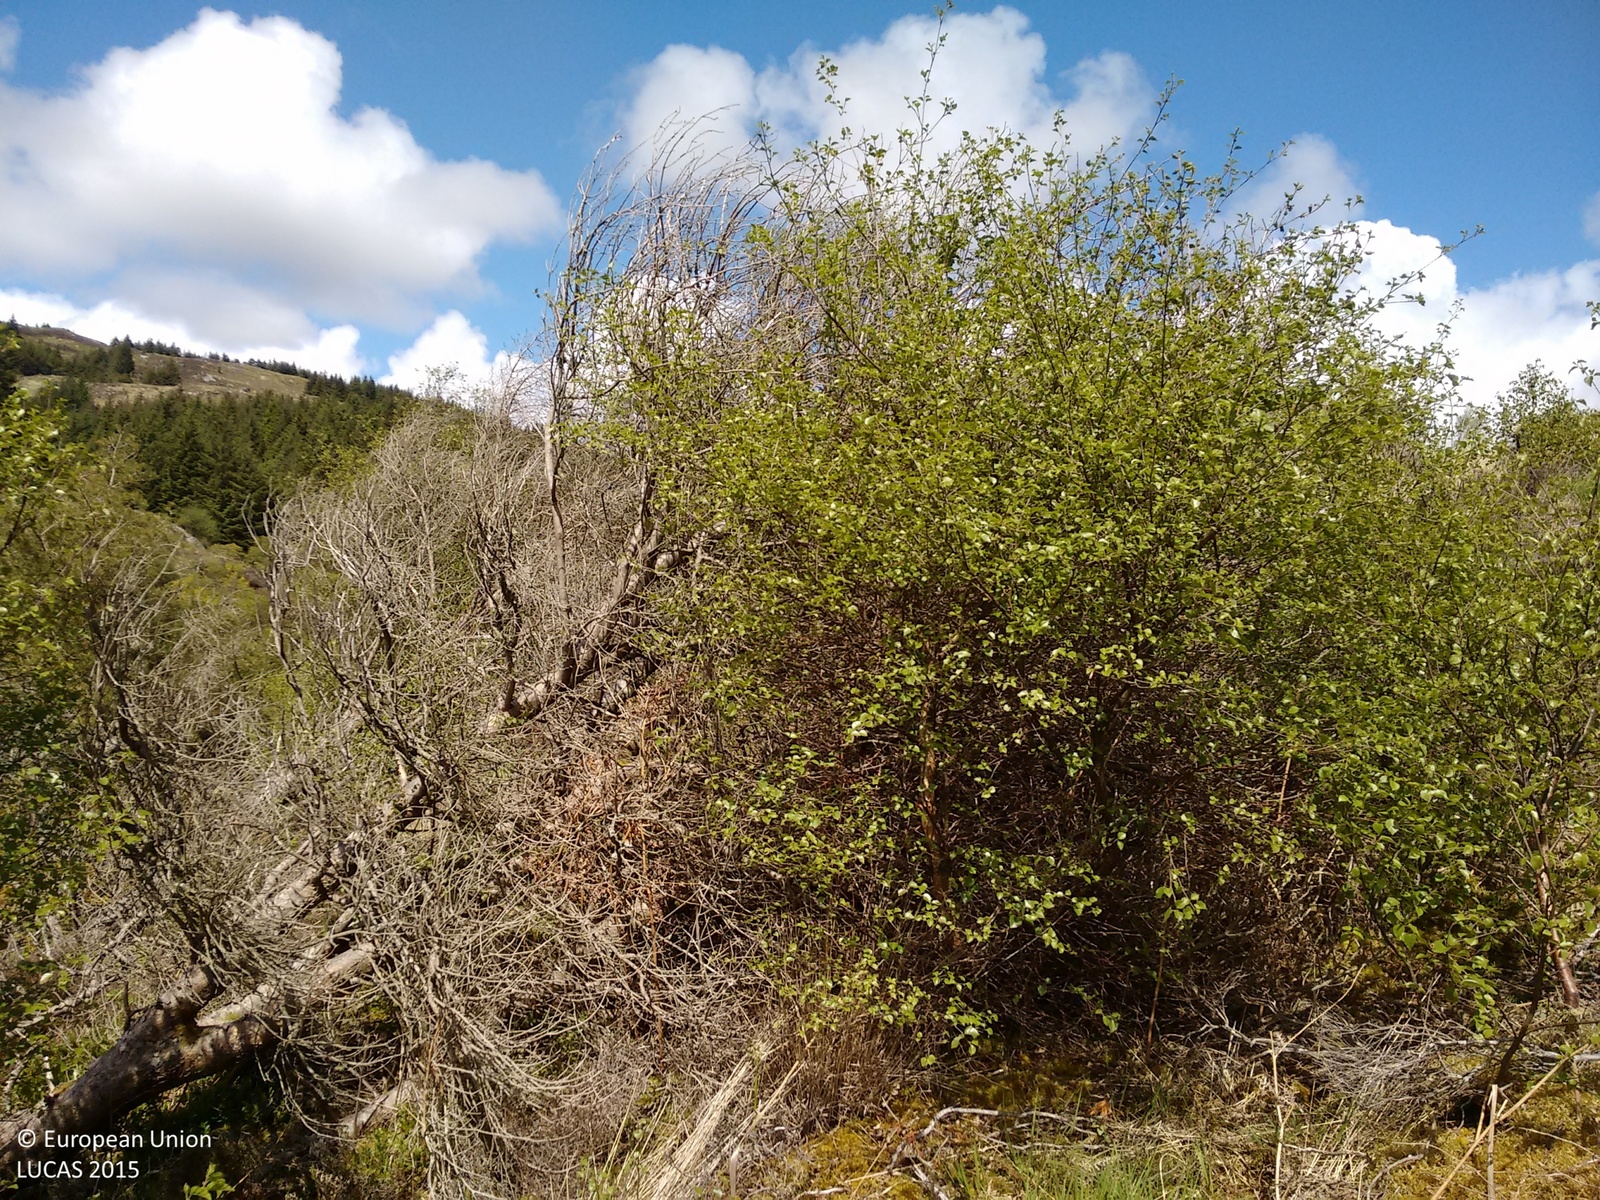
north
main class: Woodland
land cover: Broadleaved woodland
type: acidophilous oak and oak-birch forest
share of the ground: > 75 %
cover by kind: broadleaved forest trees 95 %, coniferous forest trees 5 %
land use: Semi-natural and natural areas not in use
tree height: > 5 m
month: May
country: GB
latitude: 55.9121
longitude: -5.2345
